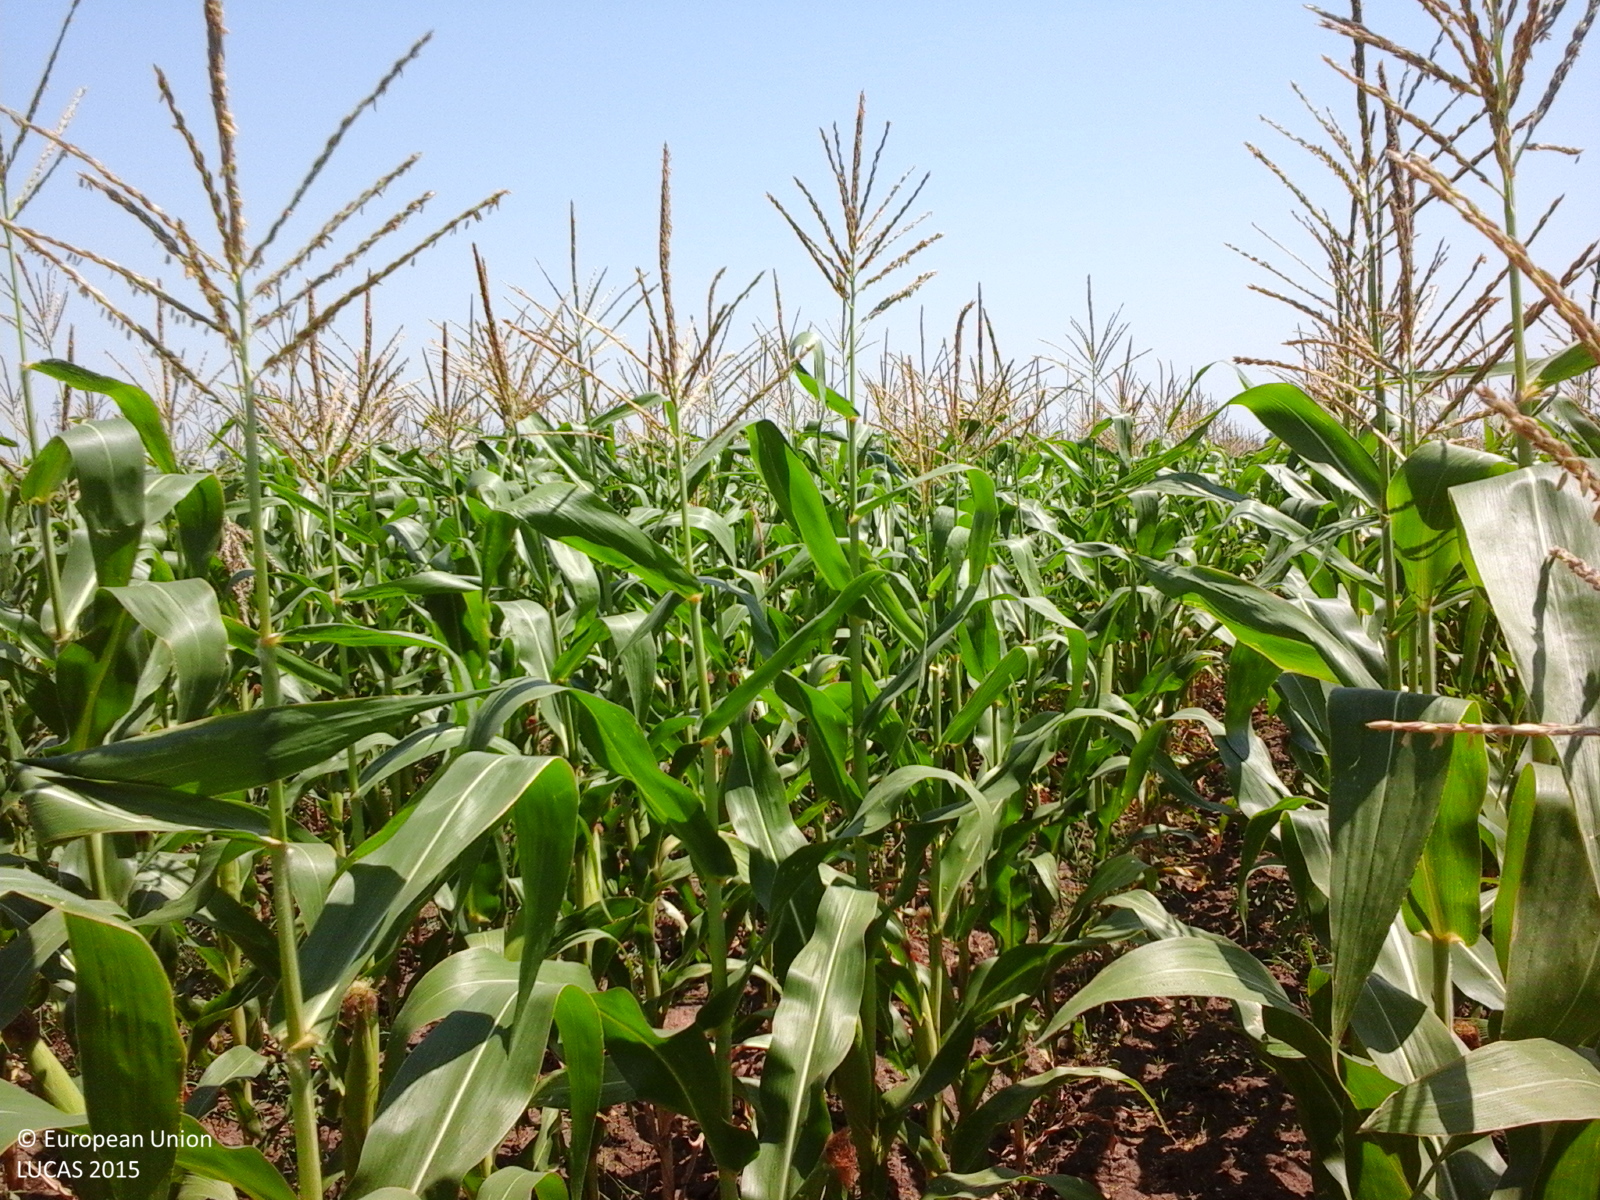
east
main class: Cropland
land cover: Maize
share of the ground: > 75 %
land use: Agriculture (excluding fallow land and kitchen gardens)
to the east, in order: Maize; Lucerne; Sunflower
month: July
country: RO
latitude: 44.9261
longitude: 27.3094
